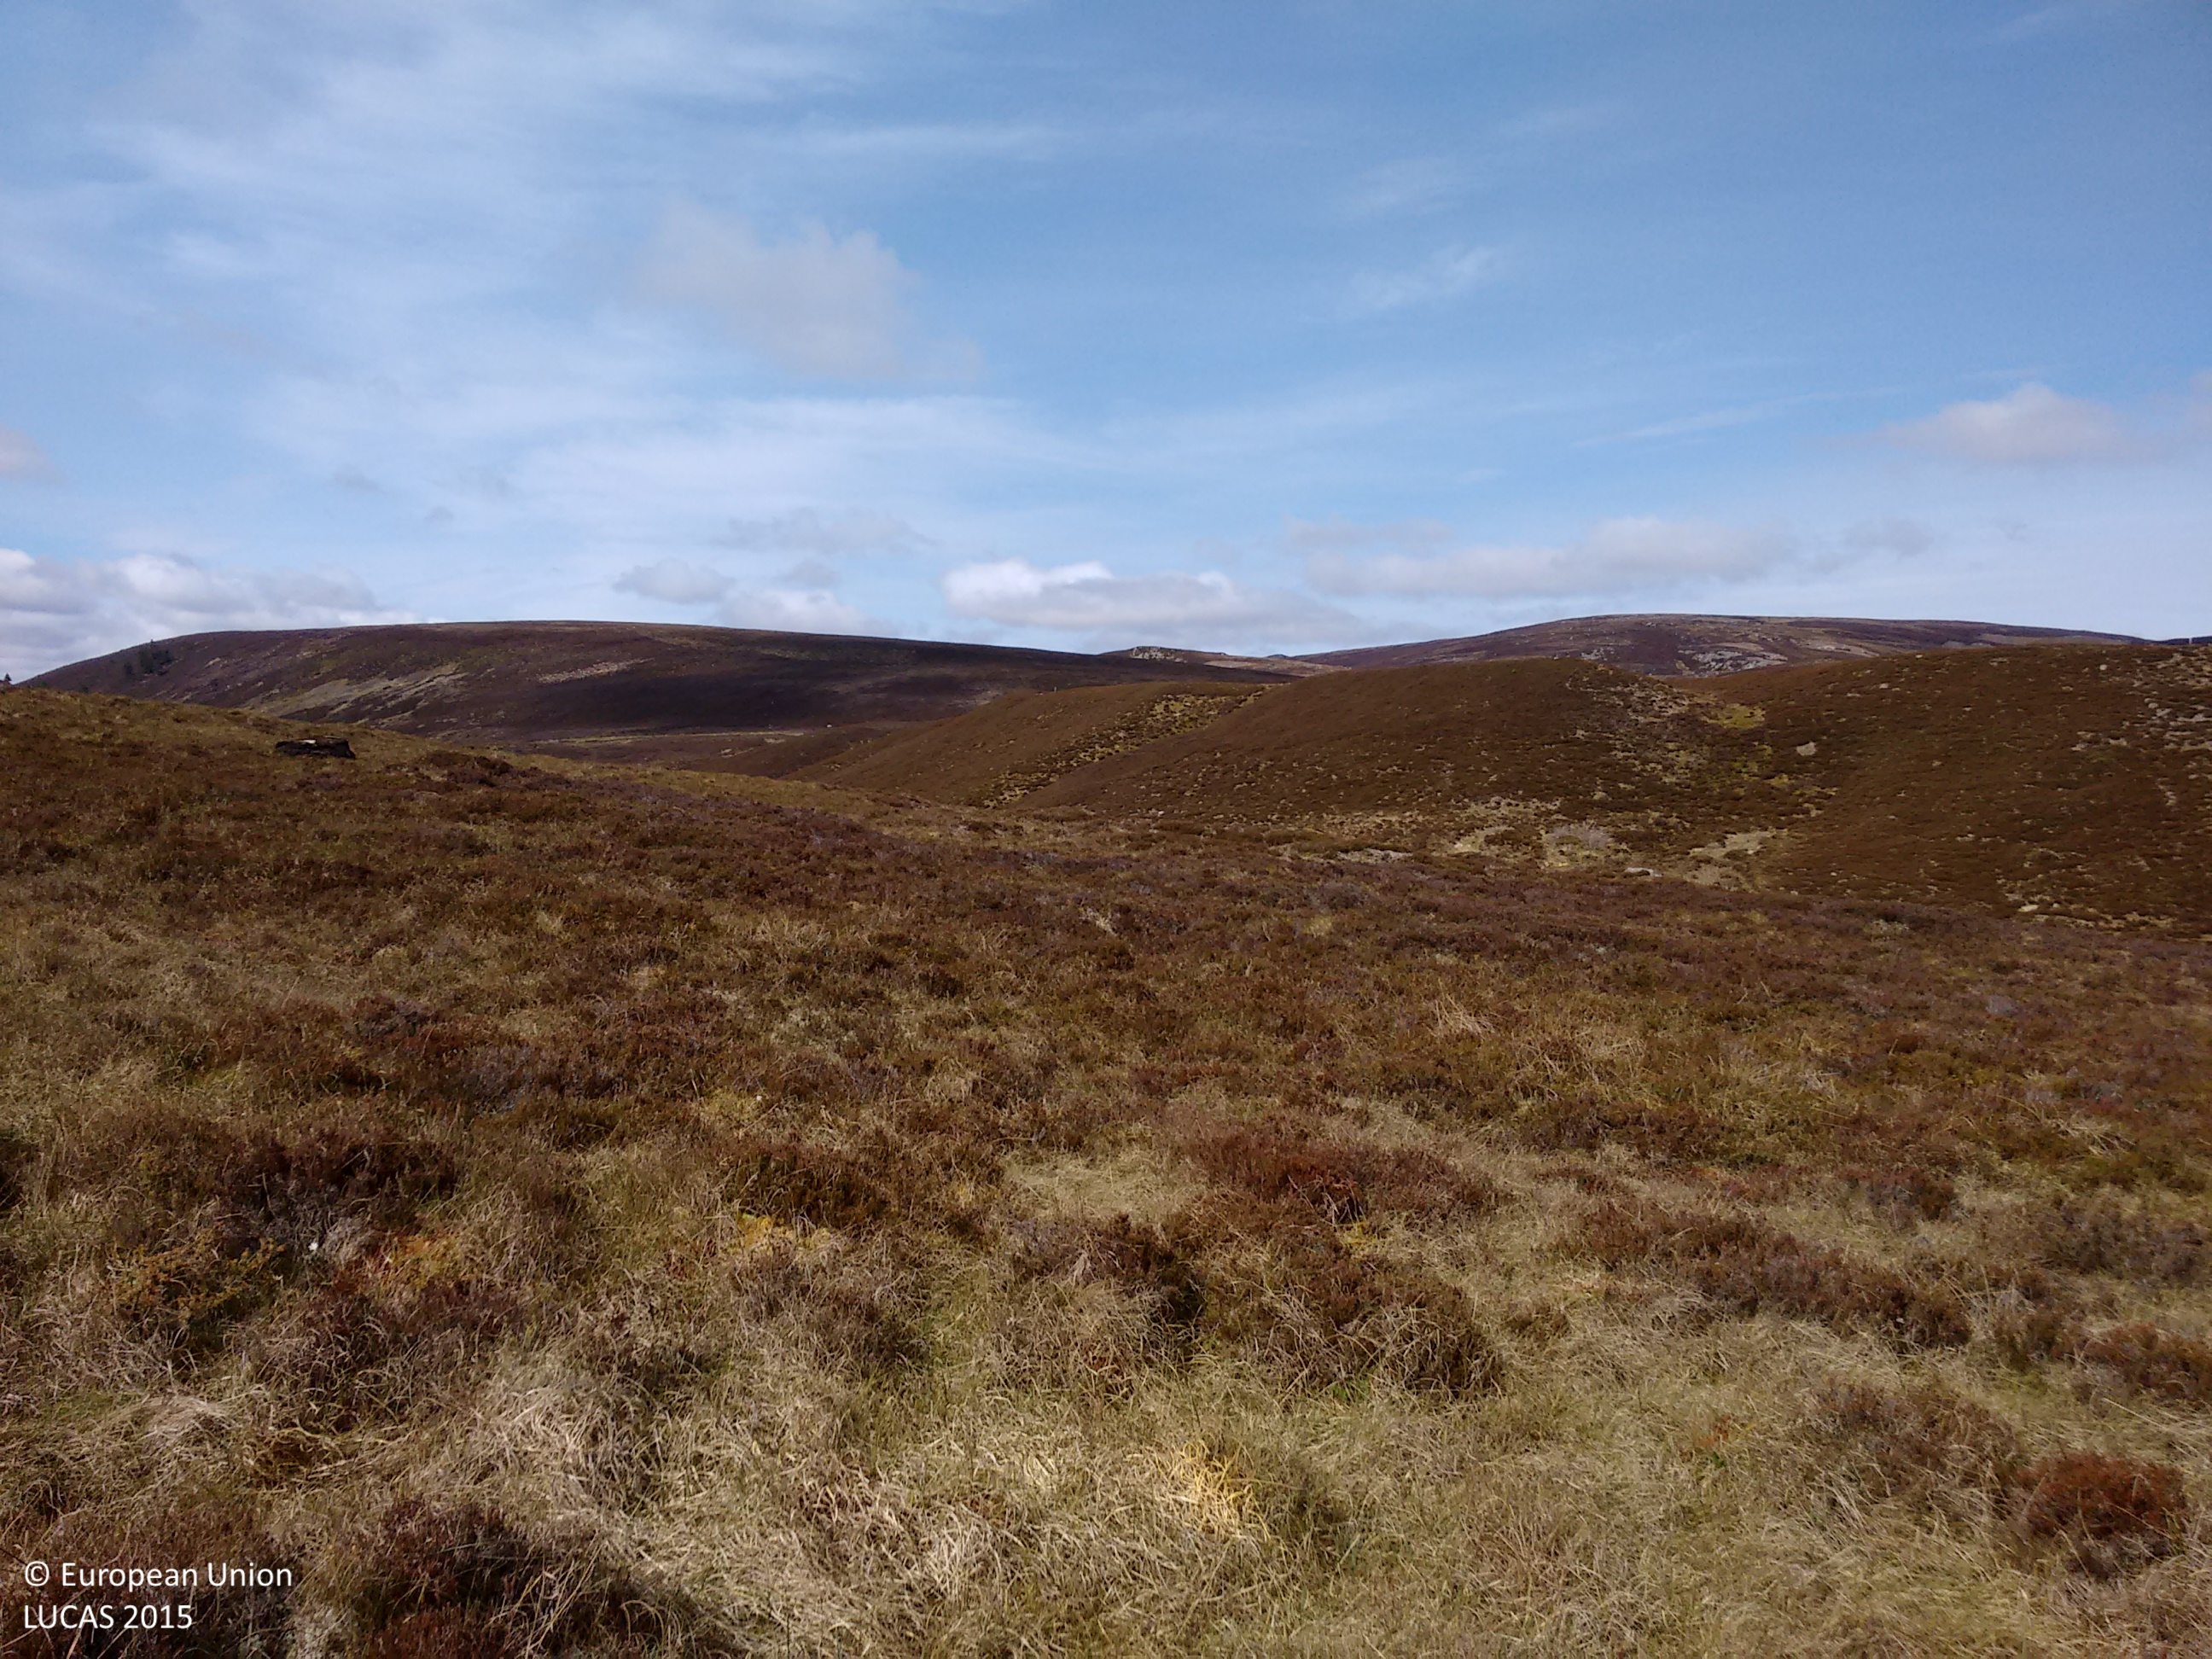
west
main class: Shrubland
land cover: Shrubland without tree cover
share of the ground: > 75 %
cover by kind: shrubs 50 %, herbaceous plants 40 %, lichens and mosses 10 %
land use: Agriculture (excluding fallow land and kitchen gardens)
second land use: Other primary production
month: June
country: GB
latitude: 57.3610
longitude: -3.7577
